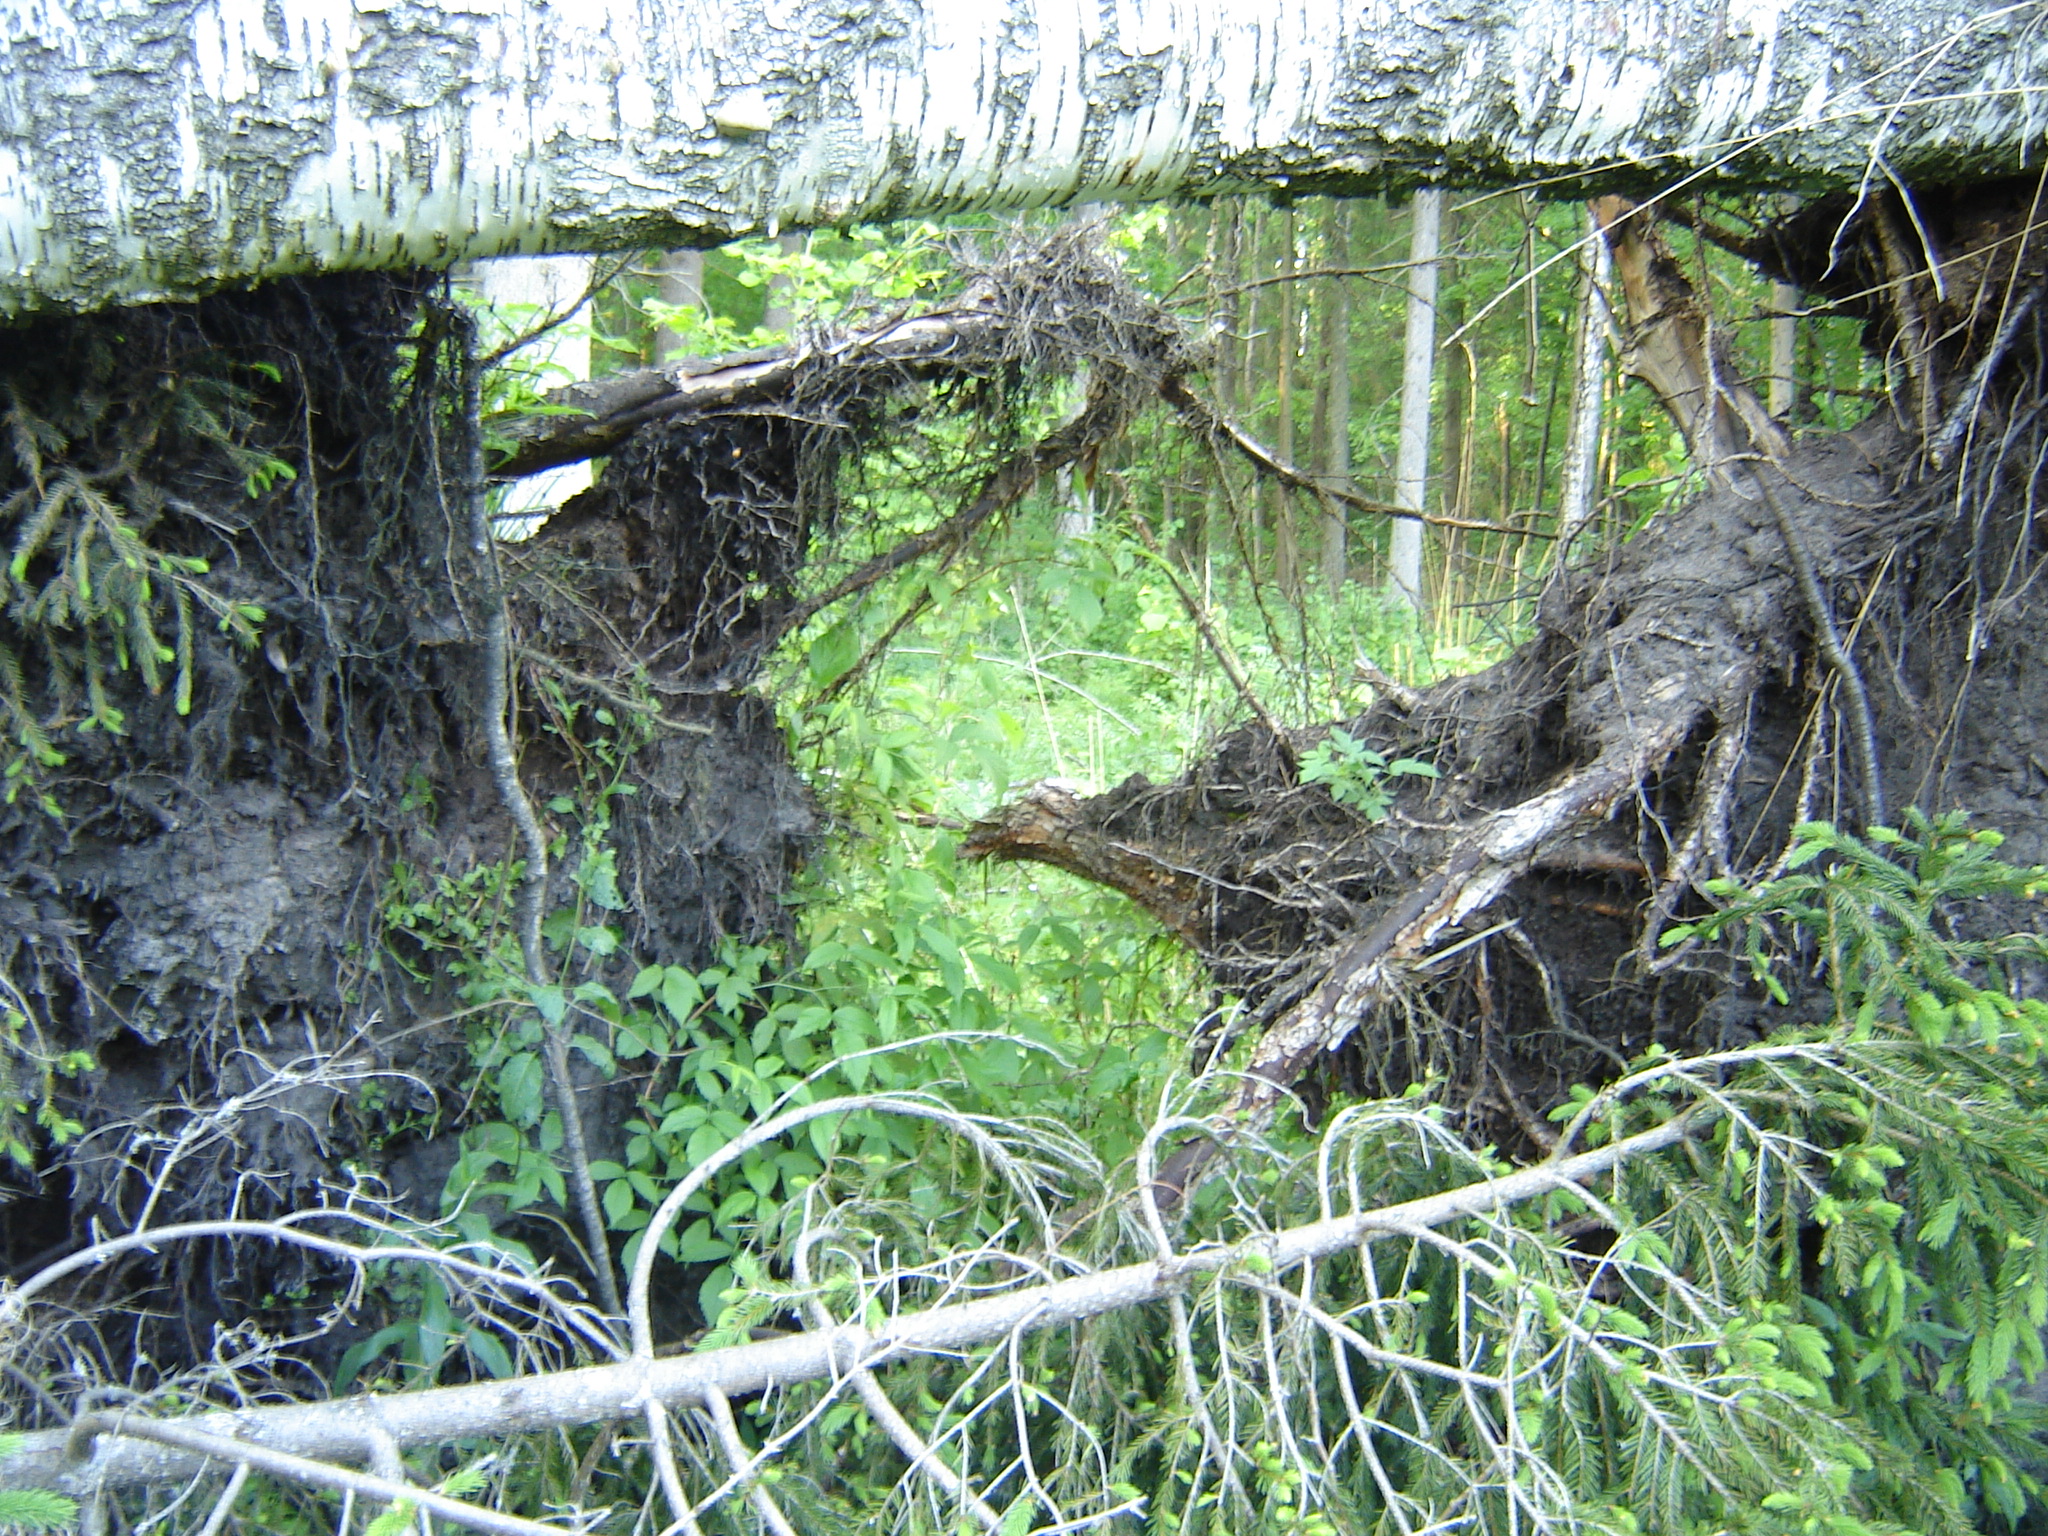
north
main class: Woodland
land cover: Spruce dominated mixed woodland
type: hemiboreal forest and nemoral coniferous forest and mixed broadleaved-coniferous forest
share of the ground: > 75 %
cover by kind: coniferous forest trees 50 %, broadleaved forest trees 30 %, herbaceous plants 20 %
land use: Forestry
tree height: > 5 m
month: June
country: LT
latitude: 55.8619
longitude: 25.3458
